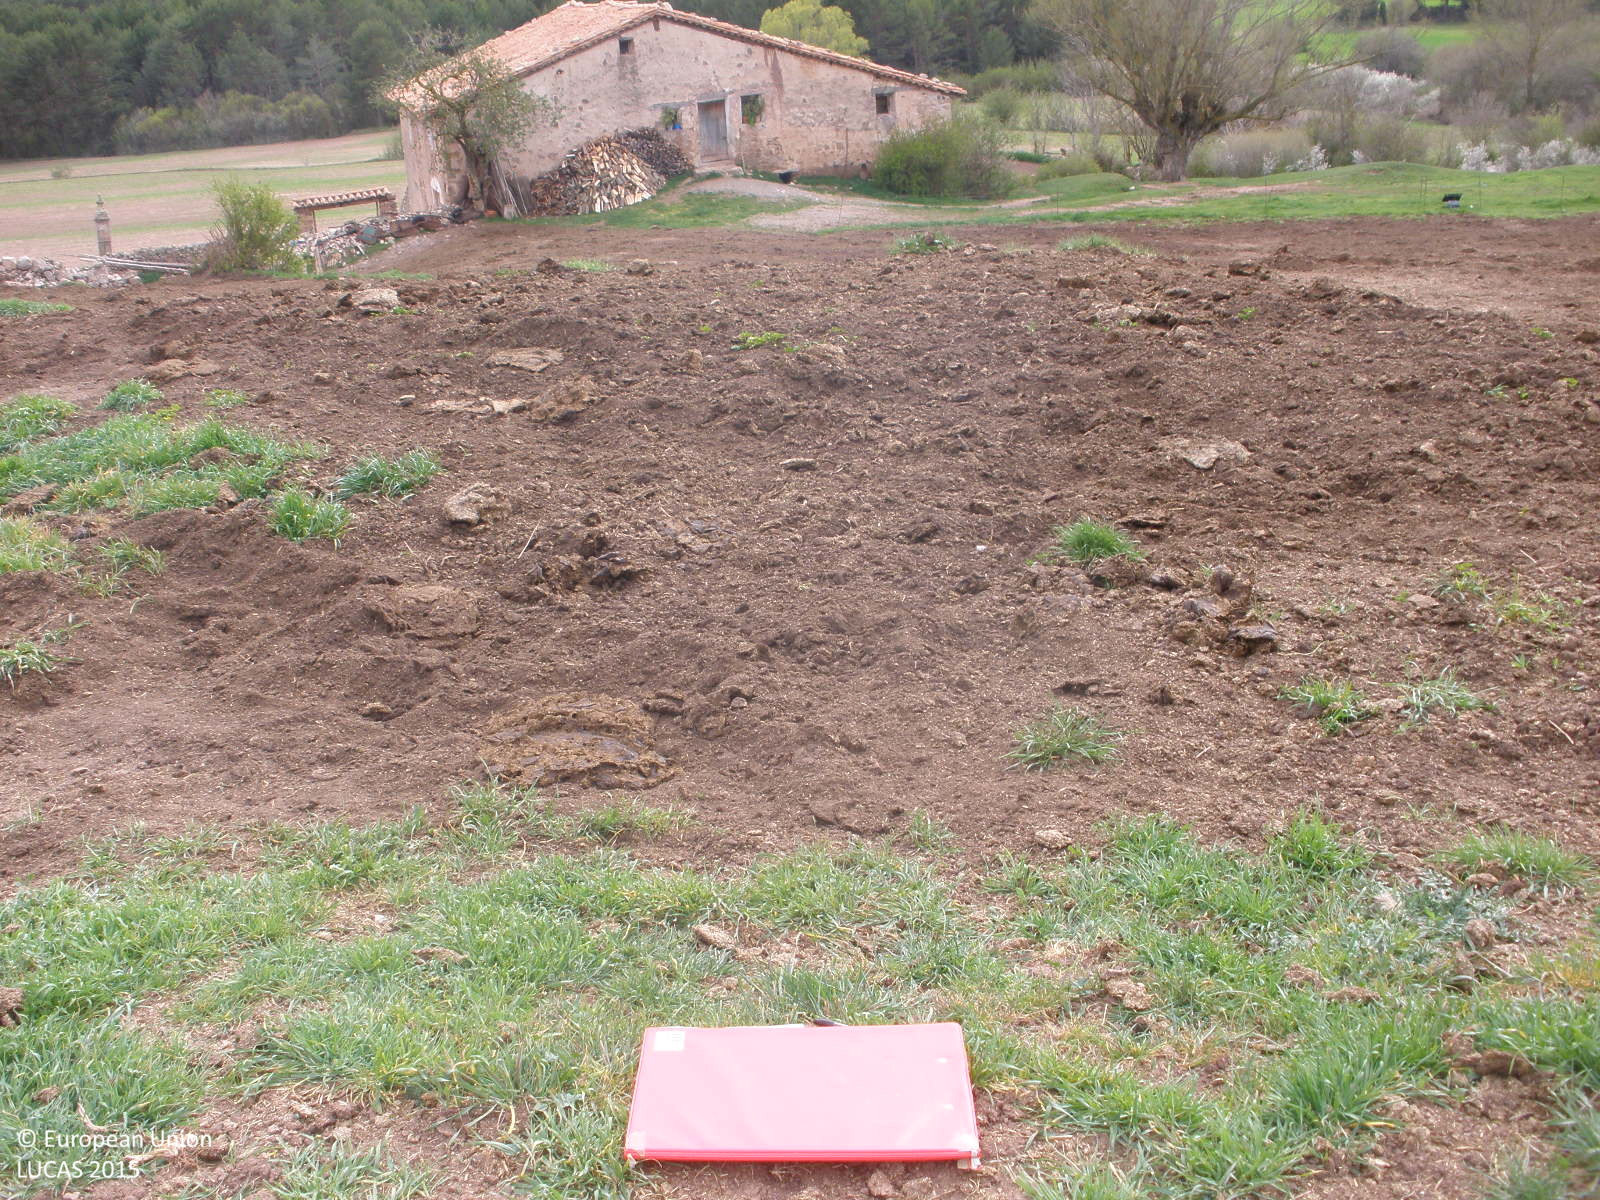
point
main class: Grassland
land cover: Grassland without tree/shrub cover
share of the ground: 50 - 75 %
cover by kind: herbaceous plants 50 %, unconsolidated bare surface 50 %
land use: Agriculture (excluding fallow land and kitchen gardens)
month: April
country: ES
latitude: 40.4152
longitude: -0.8162
